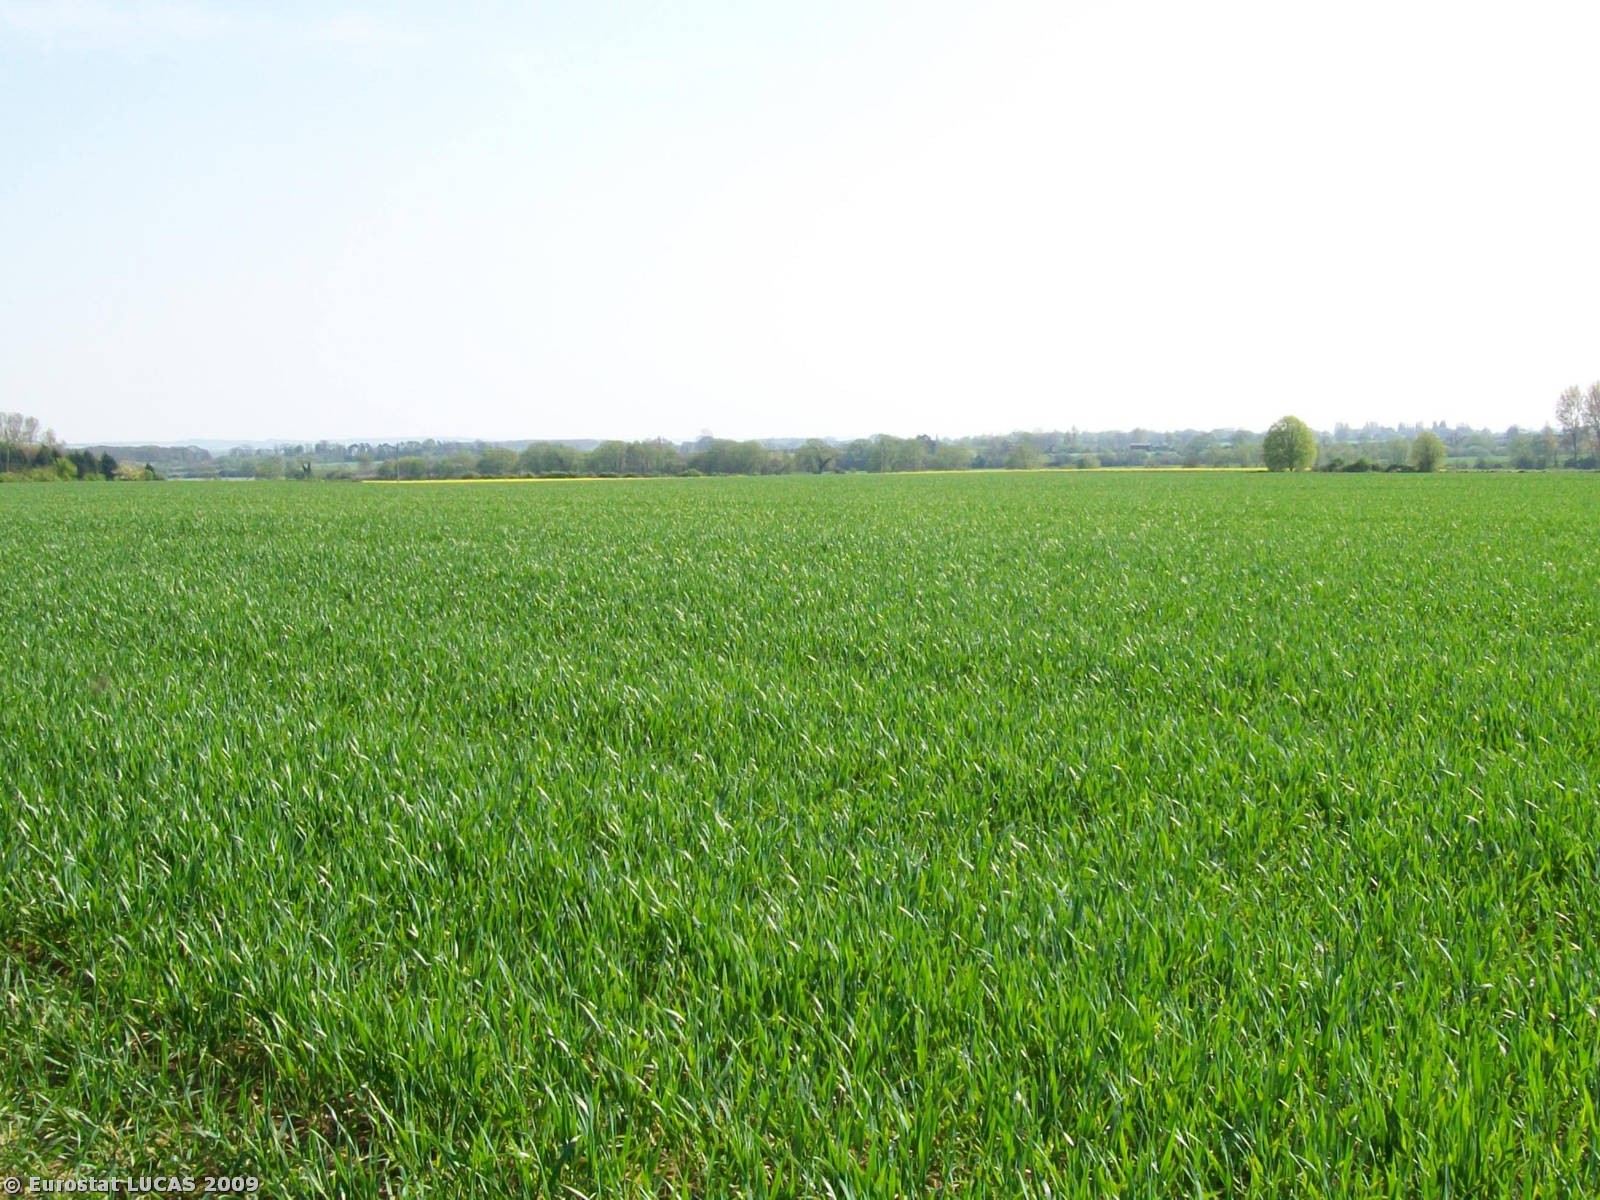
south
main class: Cropland
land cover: Common wheat
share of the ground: > 75 %
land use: Agriculture (excluding fallow land and kitchen gardens)
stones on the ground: 10 - 25 %
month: April
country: GB
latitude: 51.7083
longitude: -1.1169
